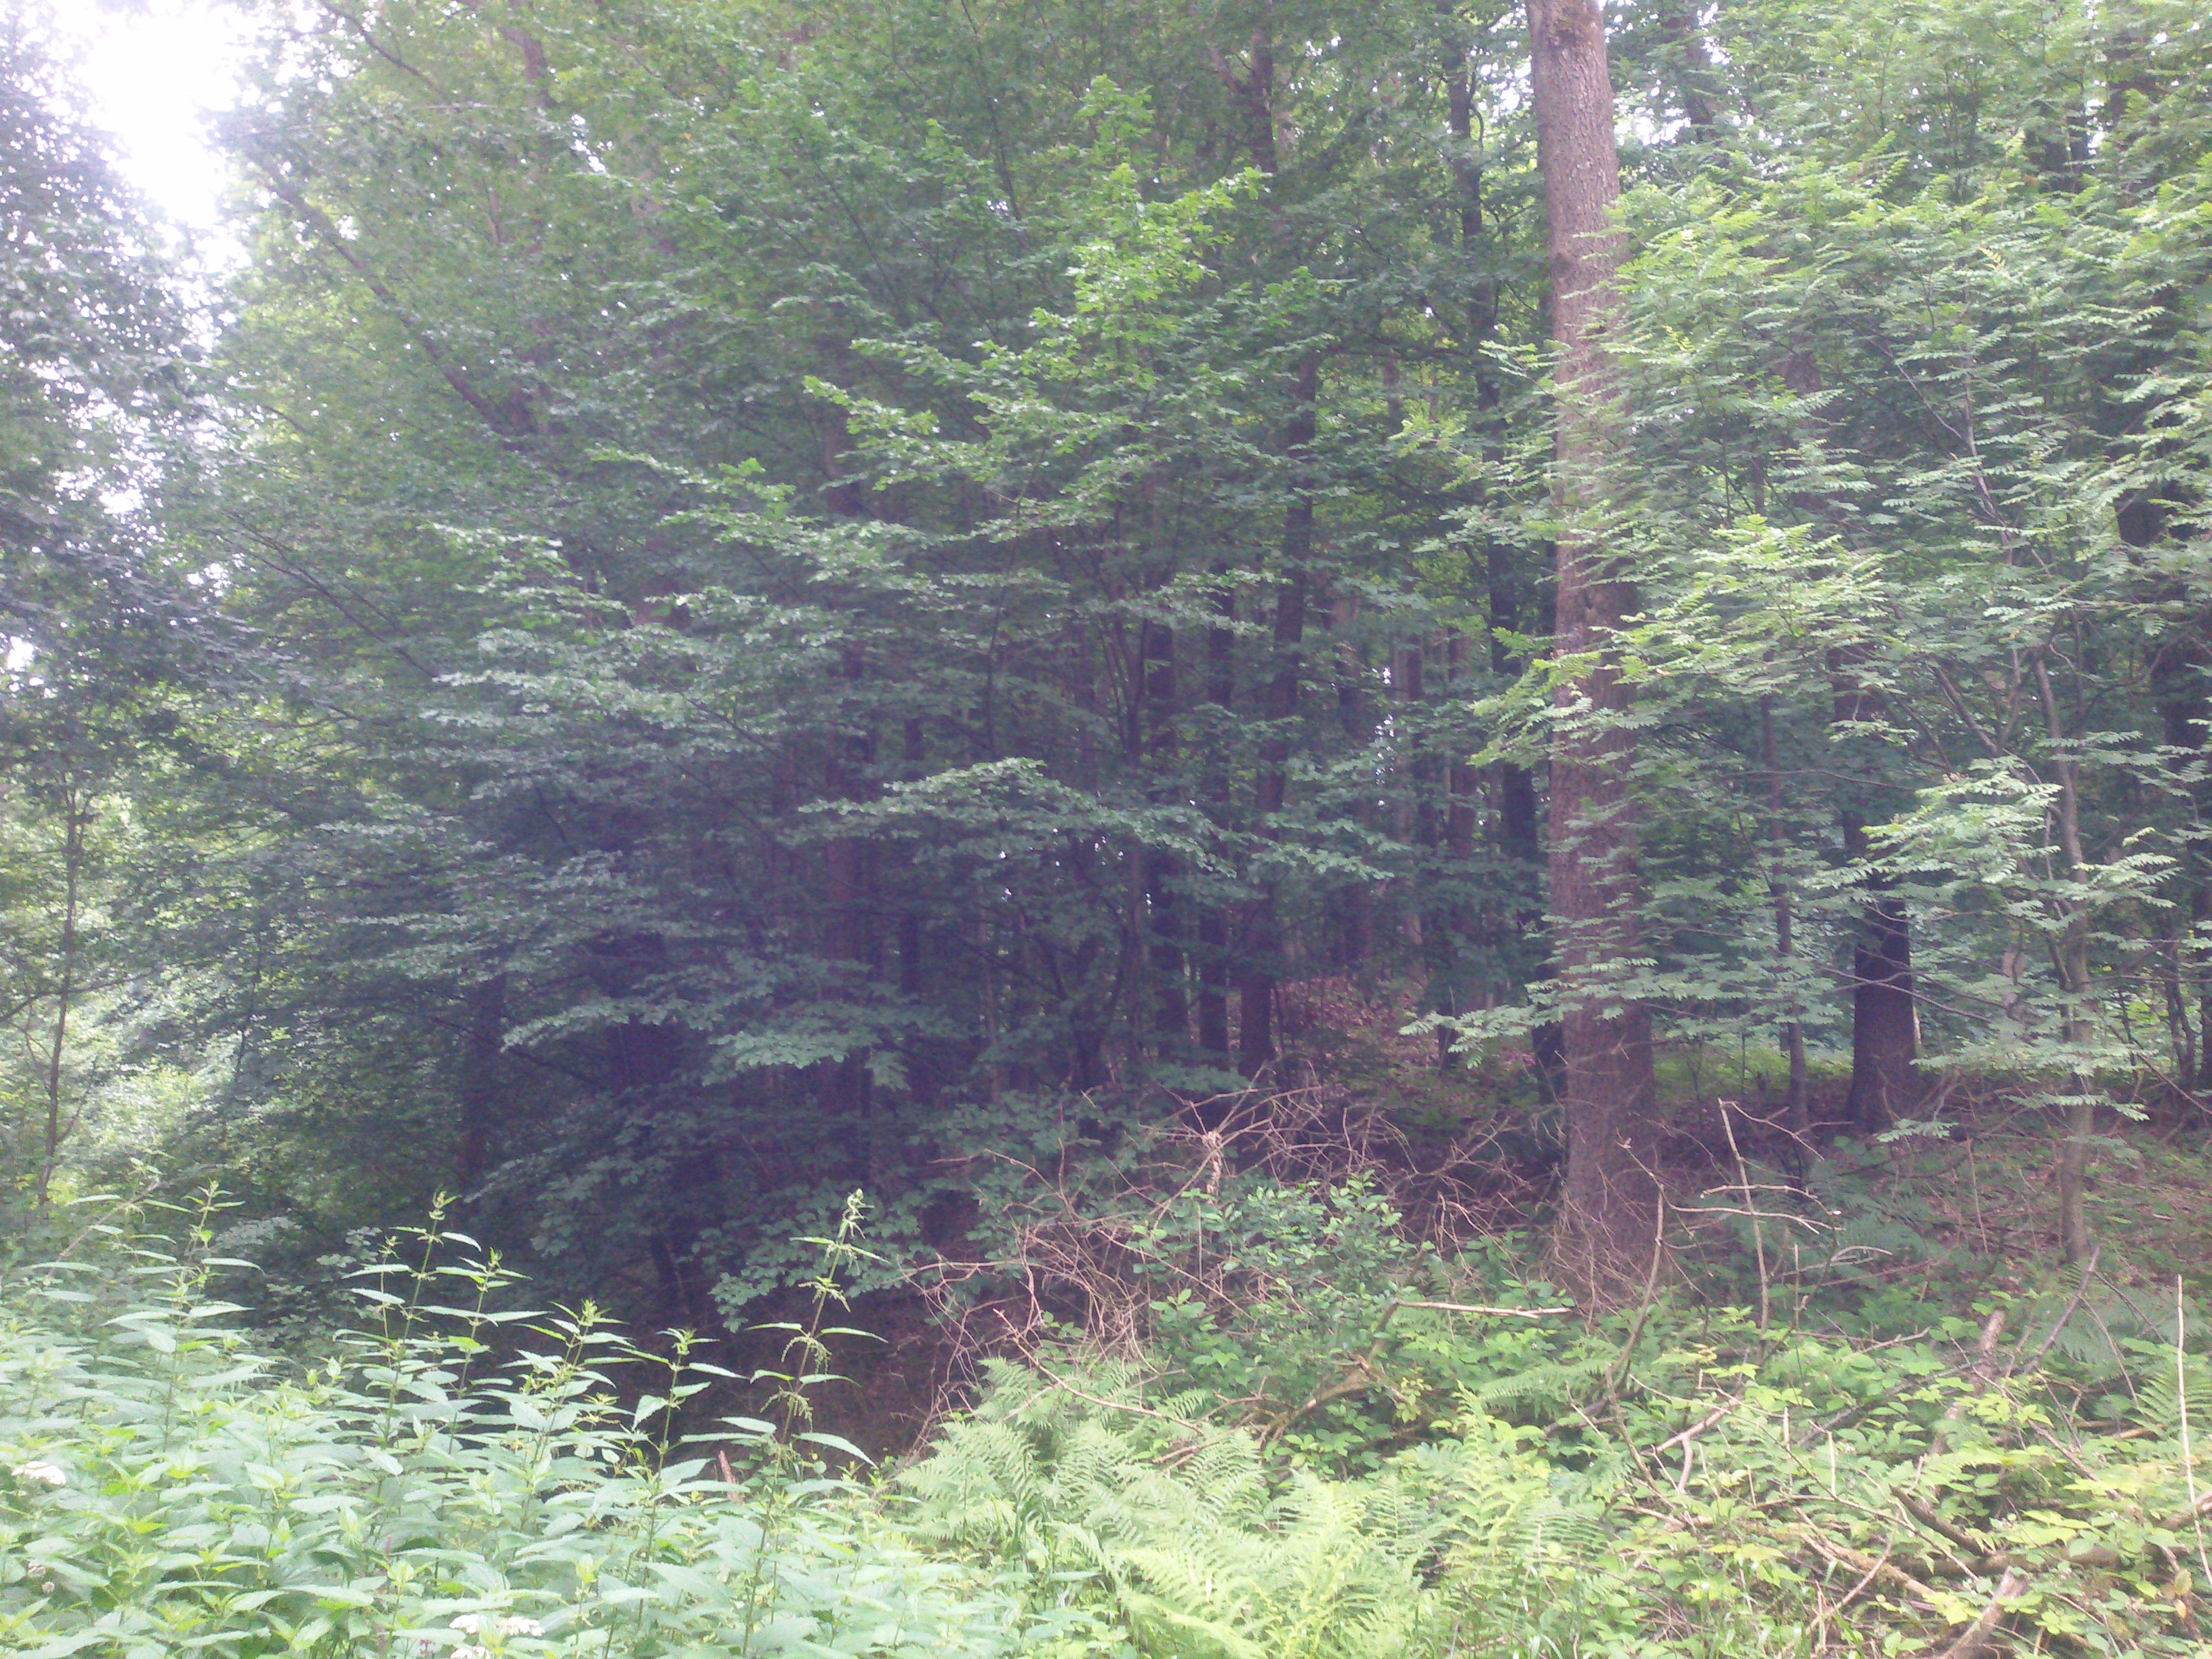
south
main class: Woodland
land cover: Broadleaved woodland
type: mesophytic deciduous forest
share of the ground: 50 - 75 %
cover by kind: broadleaved forest trees 65 %, herbaceous plants 25 %, shrubs 10 %
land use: Forestry
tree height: > 5 m
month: June
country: PL
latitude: 49.9328
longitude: 22.3079
